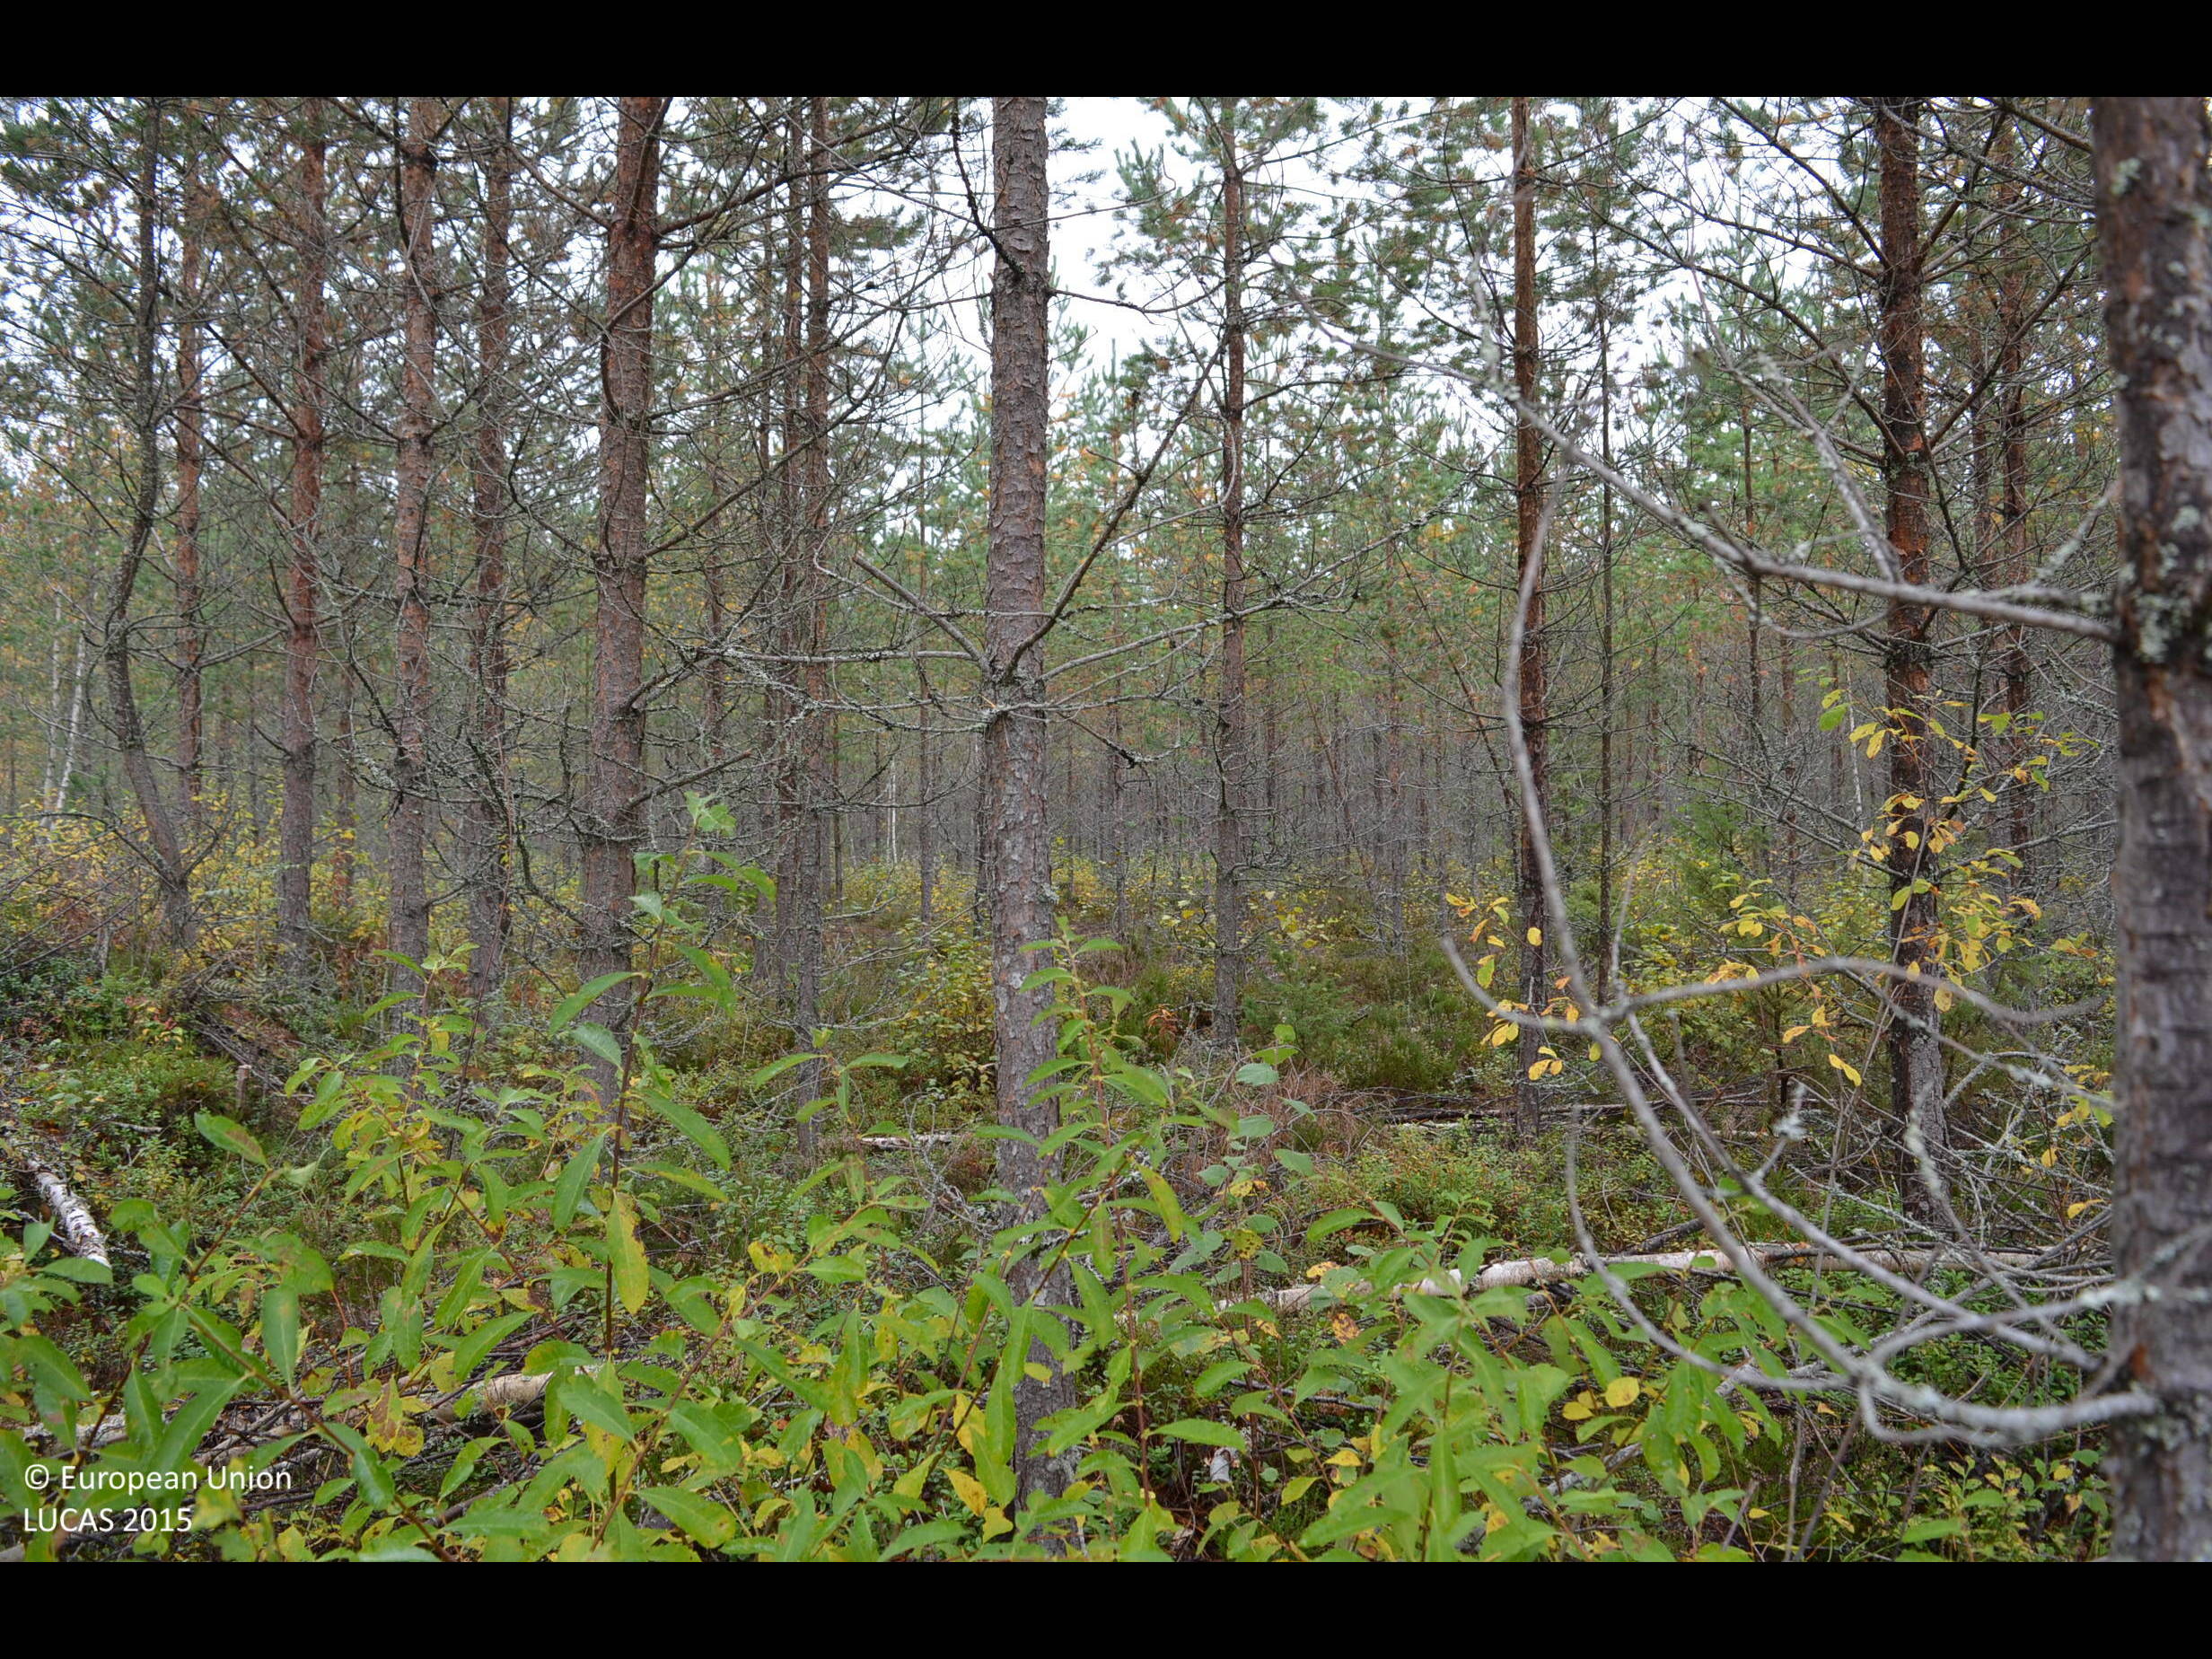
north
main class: Woodland
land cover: Pine dominated coniferous woodland
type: boreal forest
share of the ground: > 75 %
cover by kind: coniferous forest trees 75 %, shrubs 20 %, broadleaved forest trees 5 %
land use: Forestry
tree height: > 5 m
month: September
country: FI
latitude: 62.6564
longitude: 23.7539
